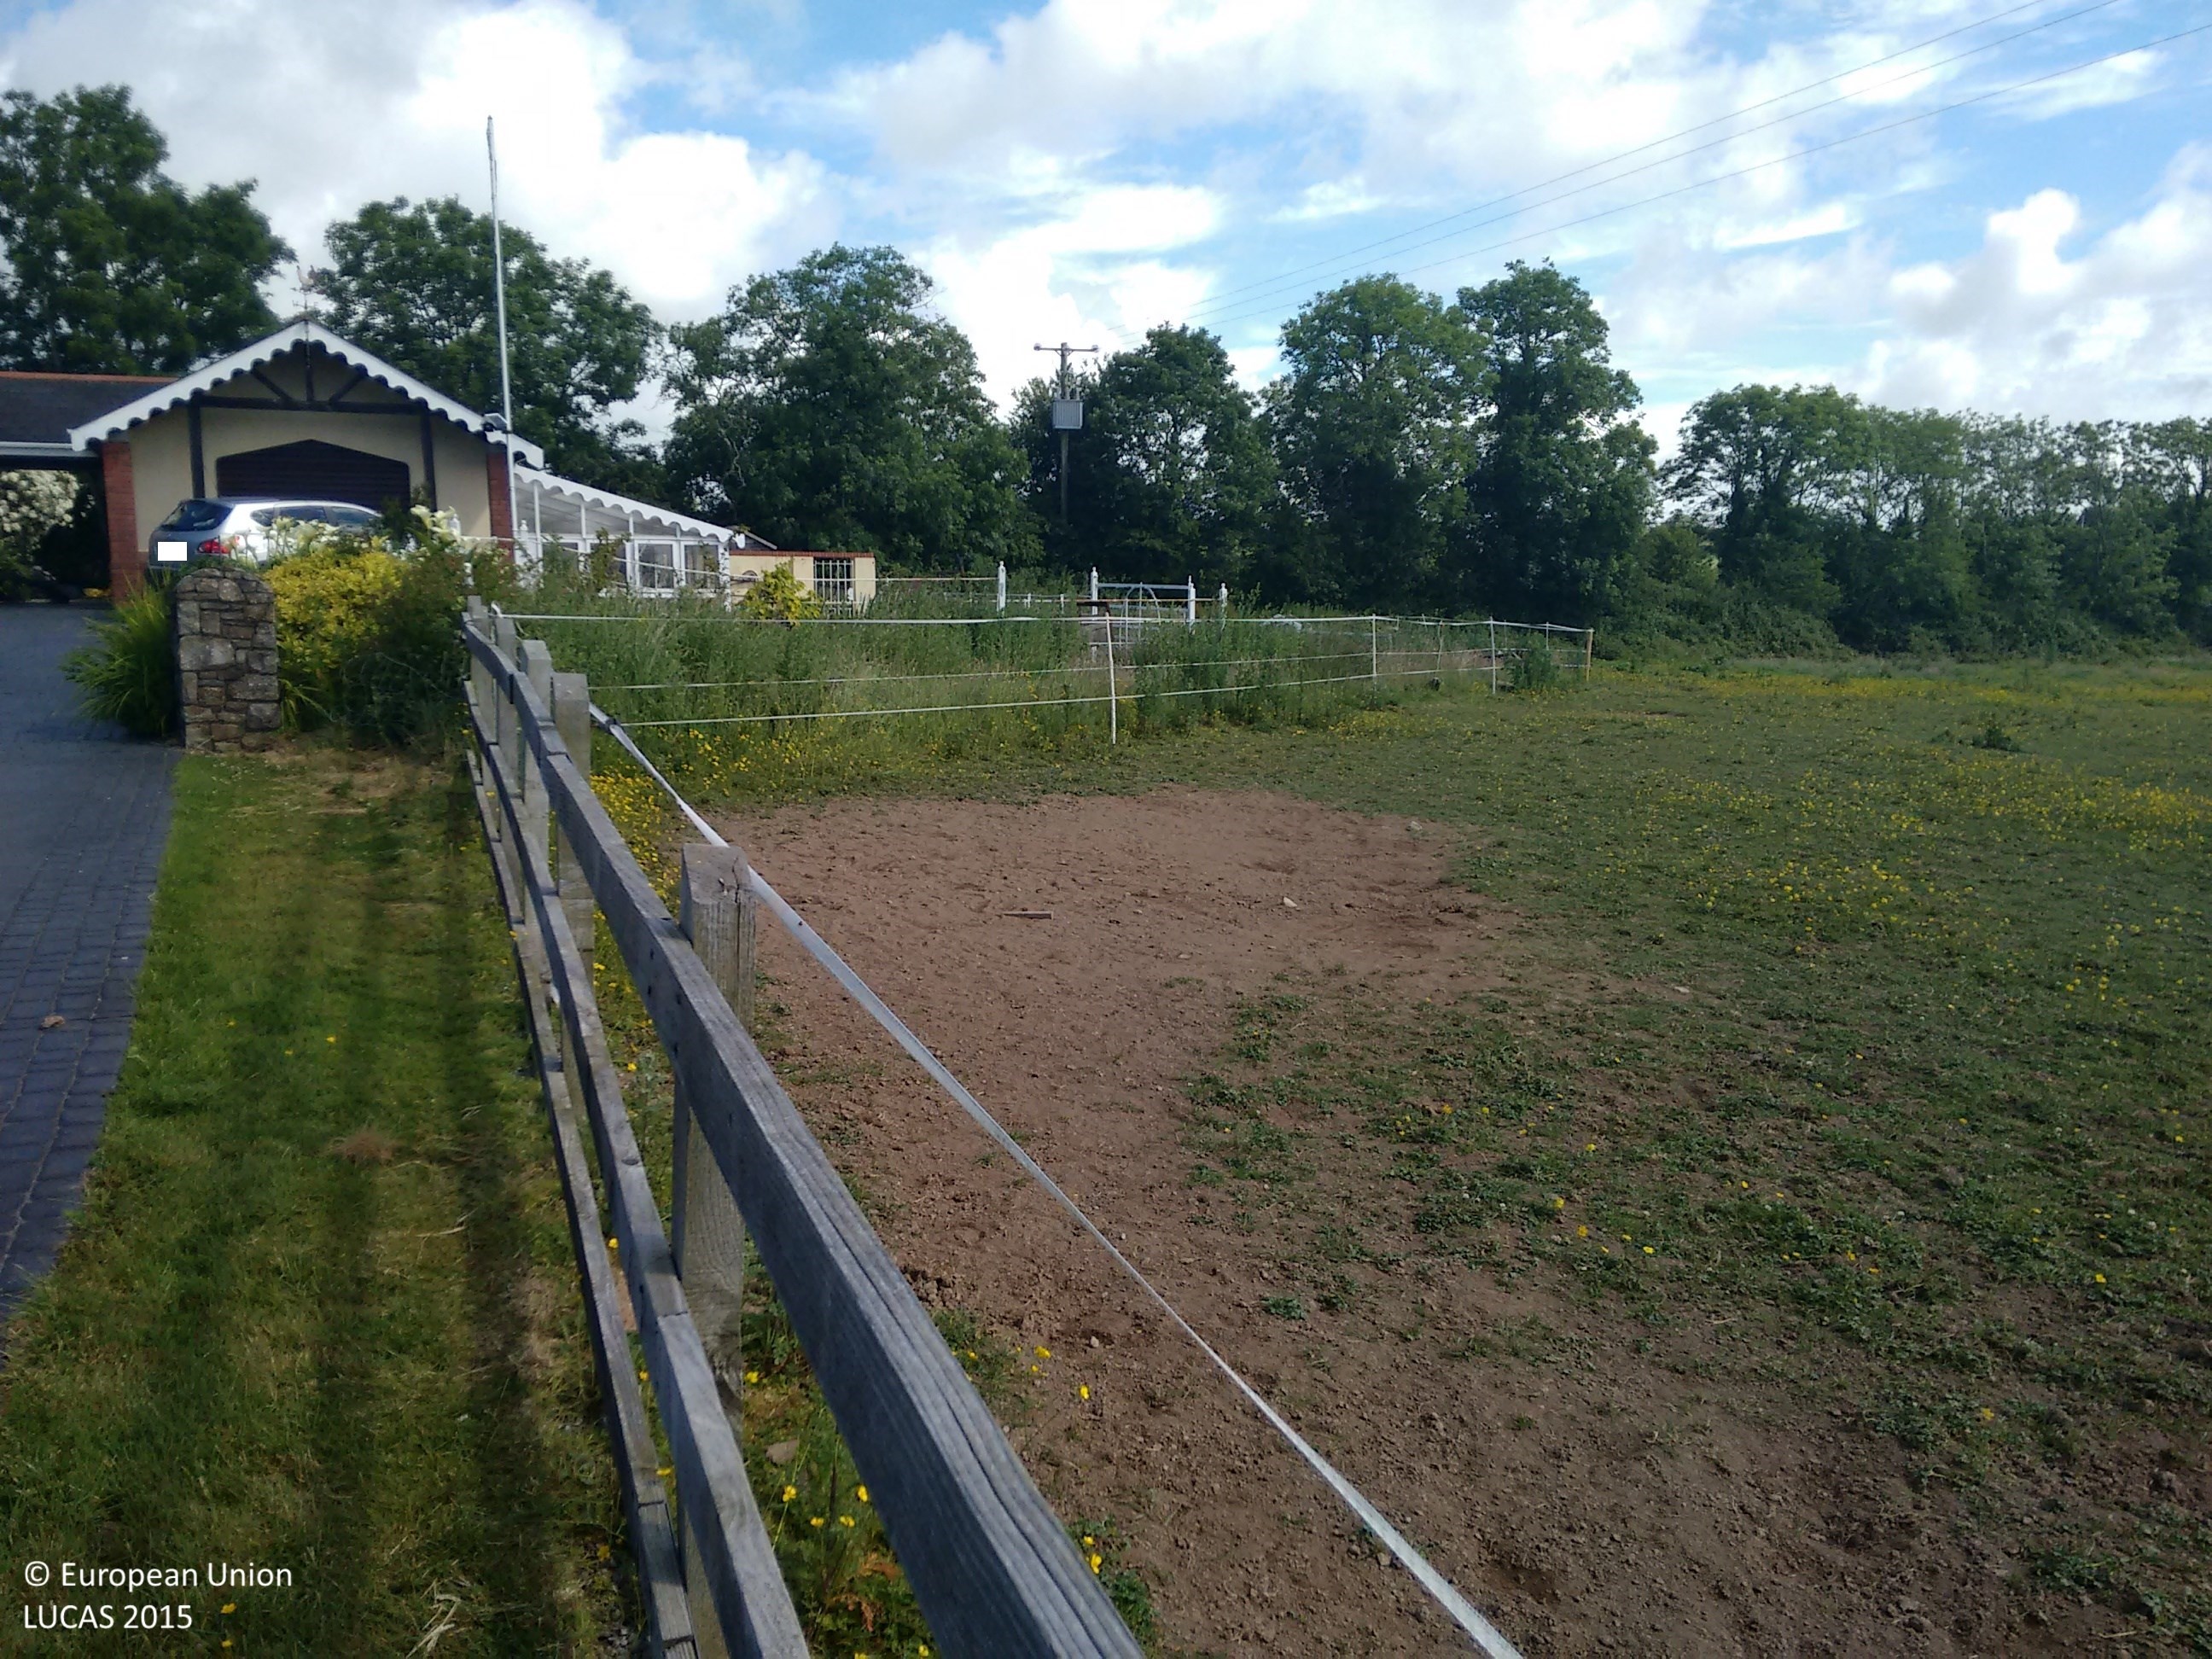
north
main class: Grassland
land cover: Grassland without tree/shrub cover
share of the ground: > 75 %
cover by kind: herbaceous plants 100 %
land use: Agriculture (excluding fallow land and kitchen gardens)
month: June
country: IE
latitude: 52.2684
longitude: -7.0703
